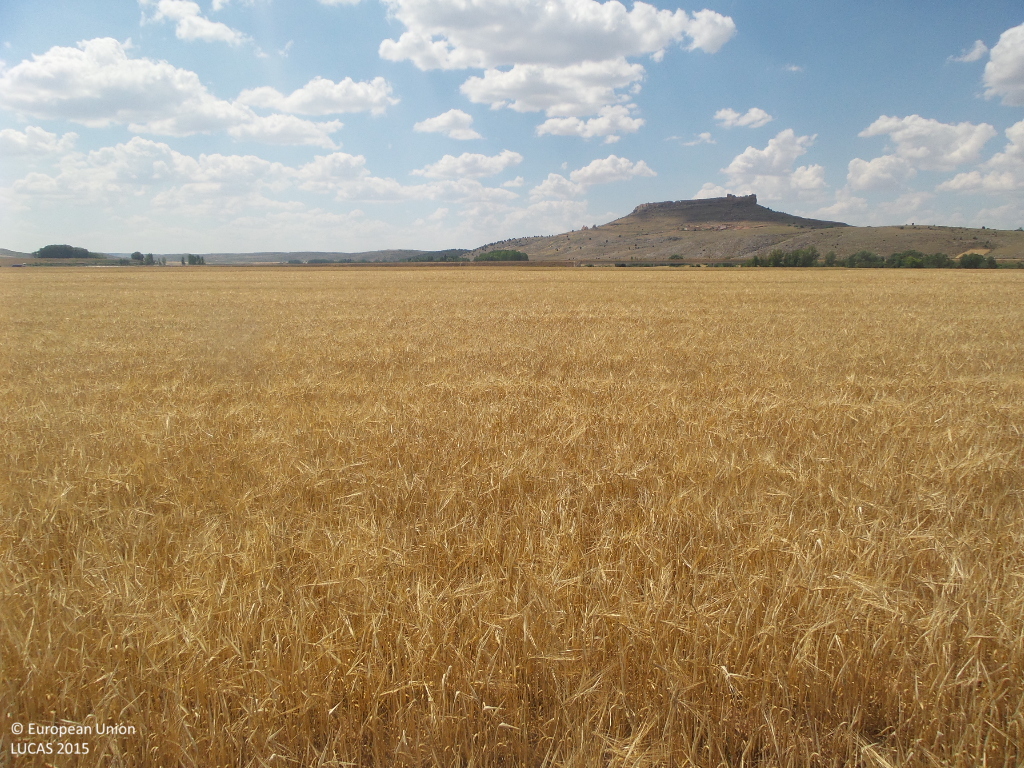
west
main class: Cropland
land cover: Barley
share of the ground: > 75 %
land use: Agriculture (excluding fallow land and kitchen gardens)
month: June
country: ES
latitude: 41.4849
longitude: -2.9880
